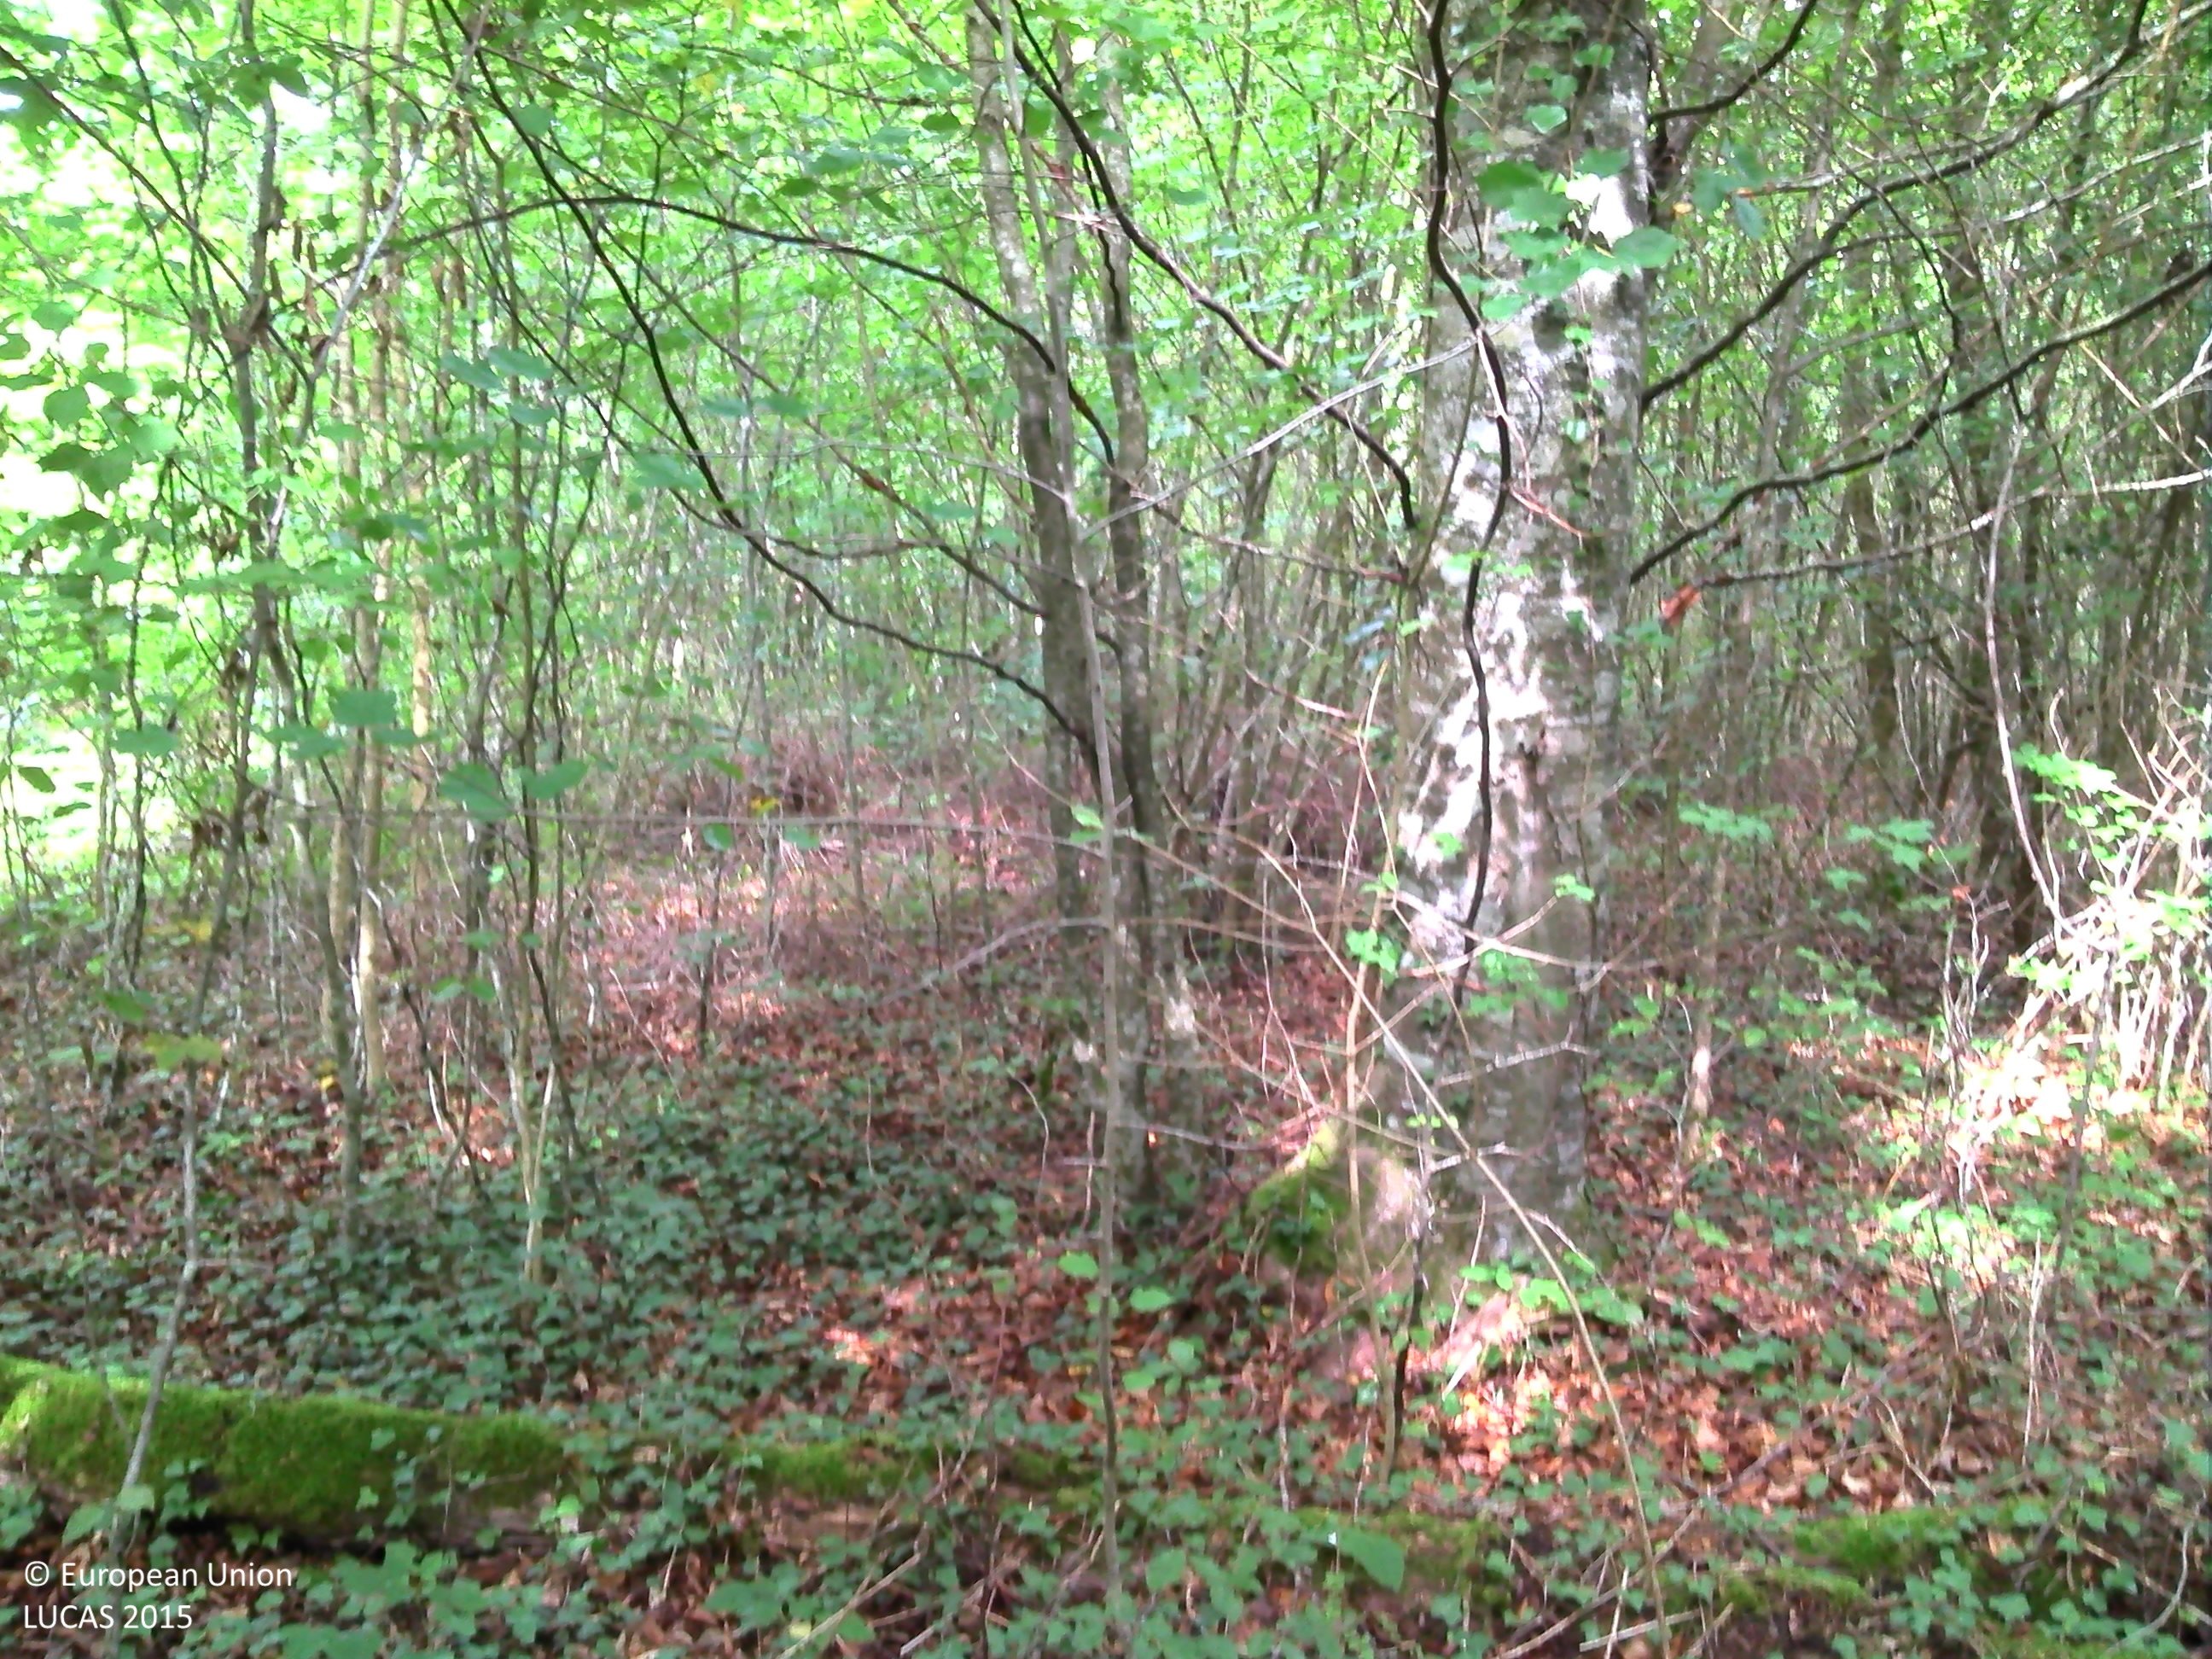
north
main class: Woodland
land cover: Broadleaved woodland
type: mesophytic deciduous forest
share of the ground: > 75 %
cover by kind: broadleaved forest trees 90 %, herbaceous plants 5 %, lichens and mosses 5 %
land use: Forestry
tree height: > 5 m
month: September
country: FR
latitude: 48.2547
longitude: 4.6238
